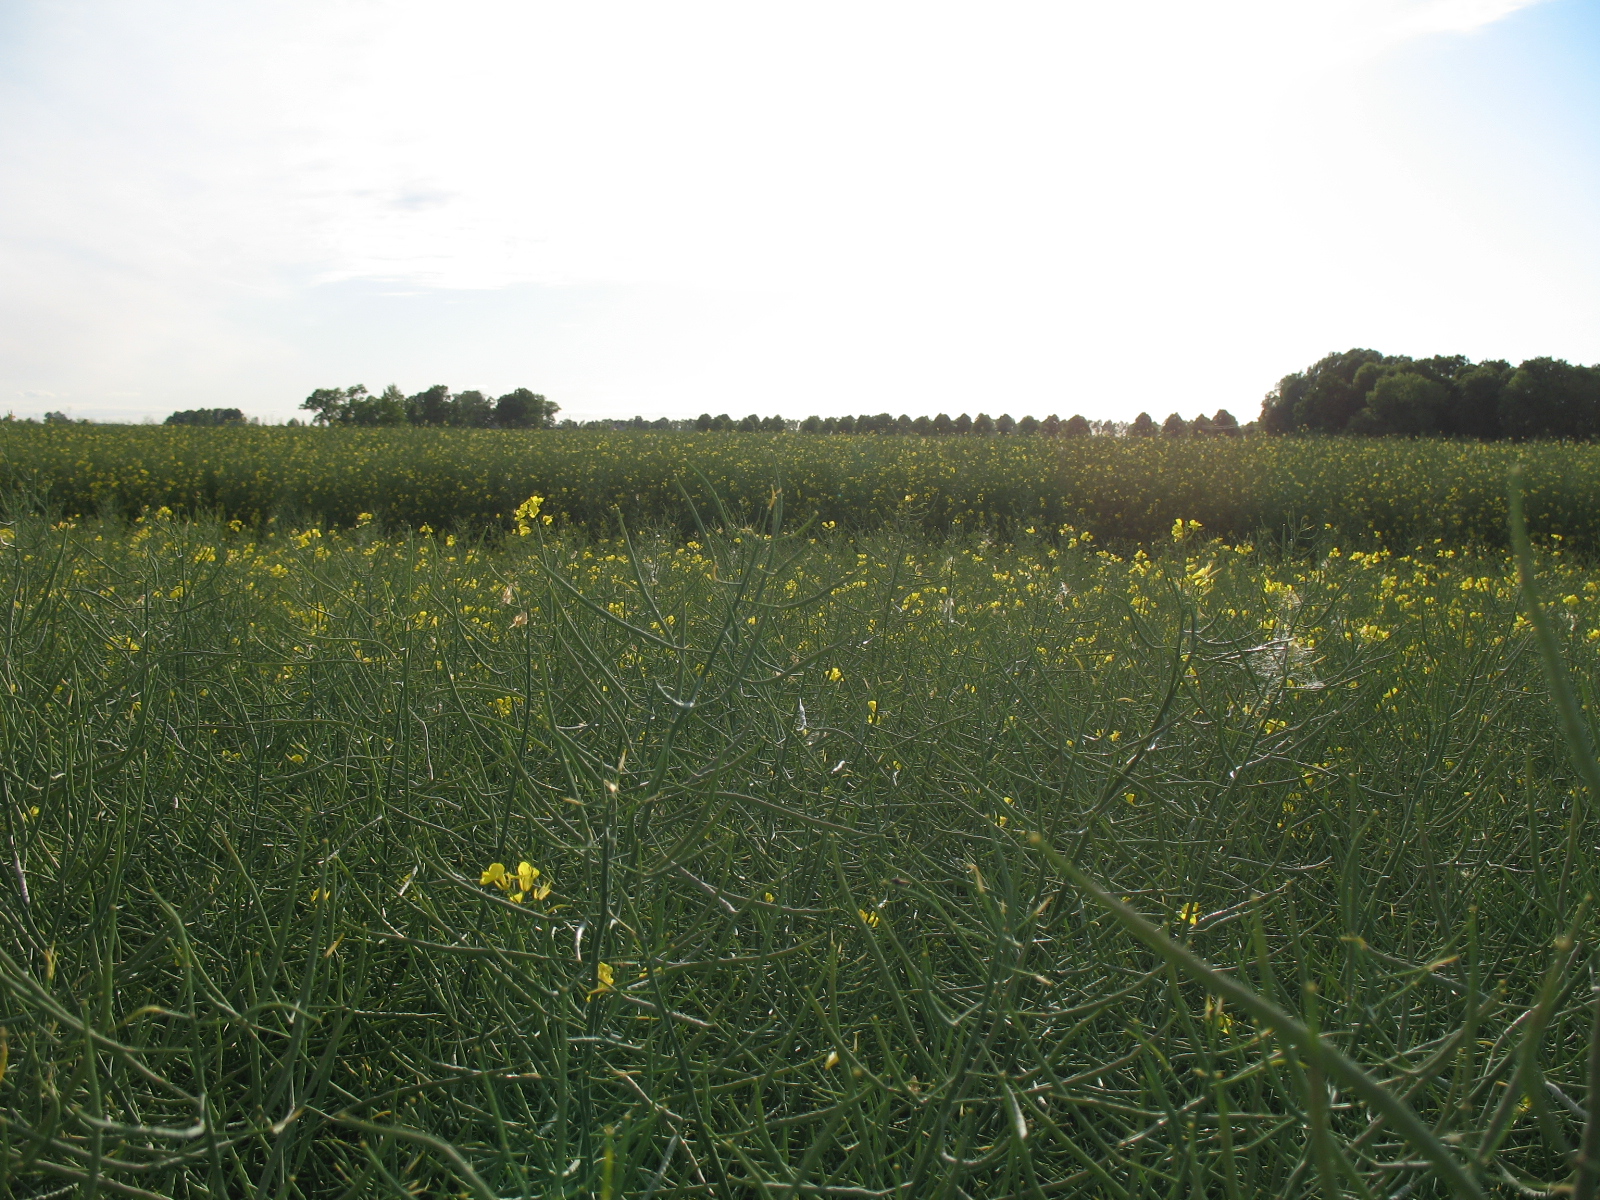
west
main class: Cropland
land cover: Rape and turnip rape
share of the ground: > 75 %
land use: Agriculture (excluding fallow land and kitchen gardens)
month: June
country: LV
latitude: 56.5866
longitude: 23.4747
